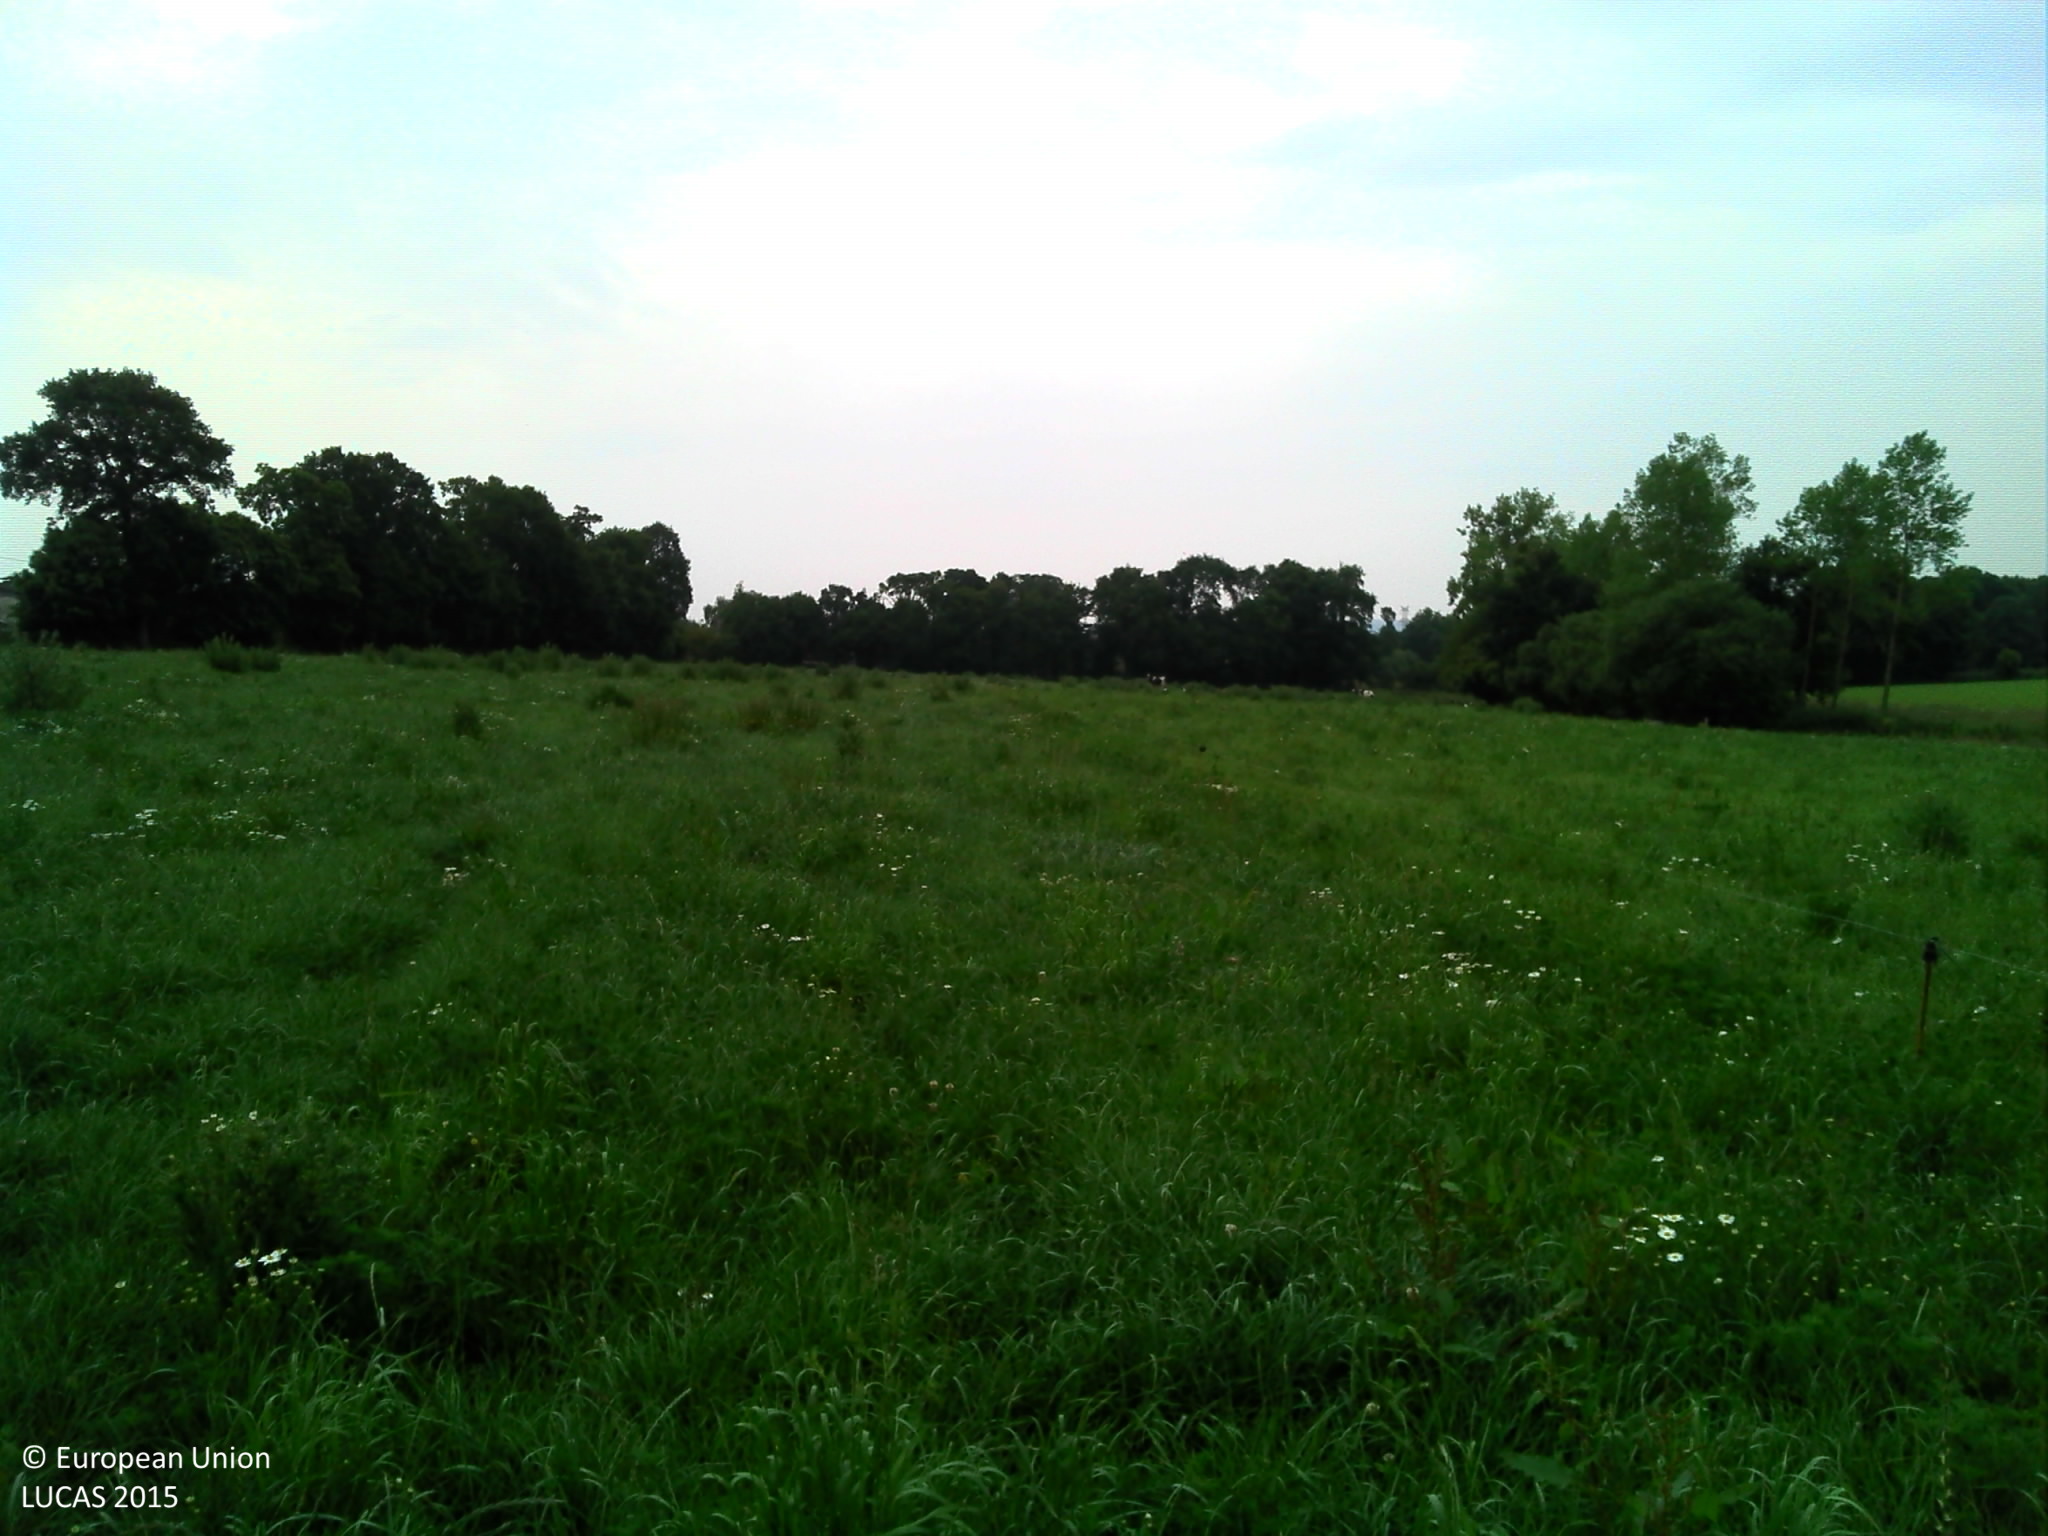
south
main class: Grassland
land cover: Grassland without tree/shrub cover
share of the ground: > 75 %
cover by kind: herbaceous plants 100 %
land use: Agriculture (excluding fallow land and kitchen gardens)
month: June
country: FR
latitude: 48.1562
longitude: -2.0856
